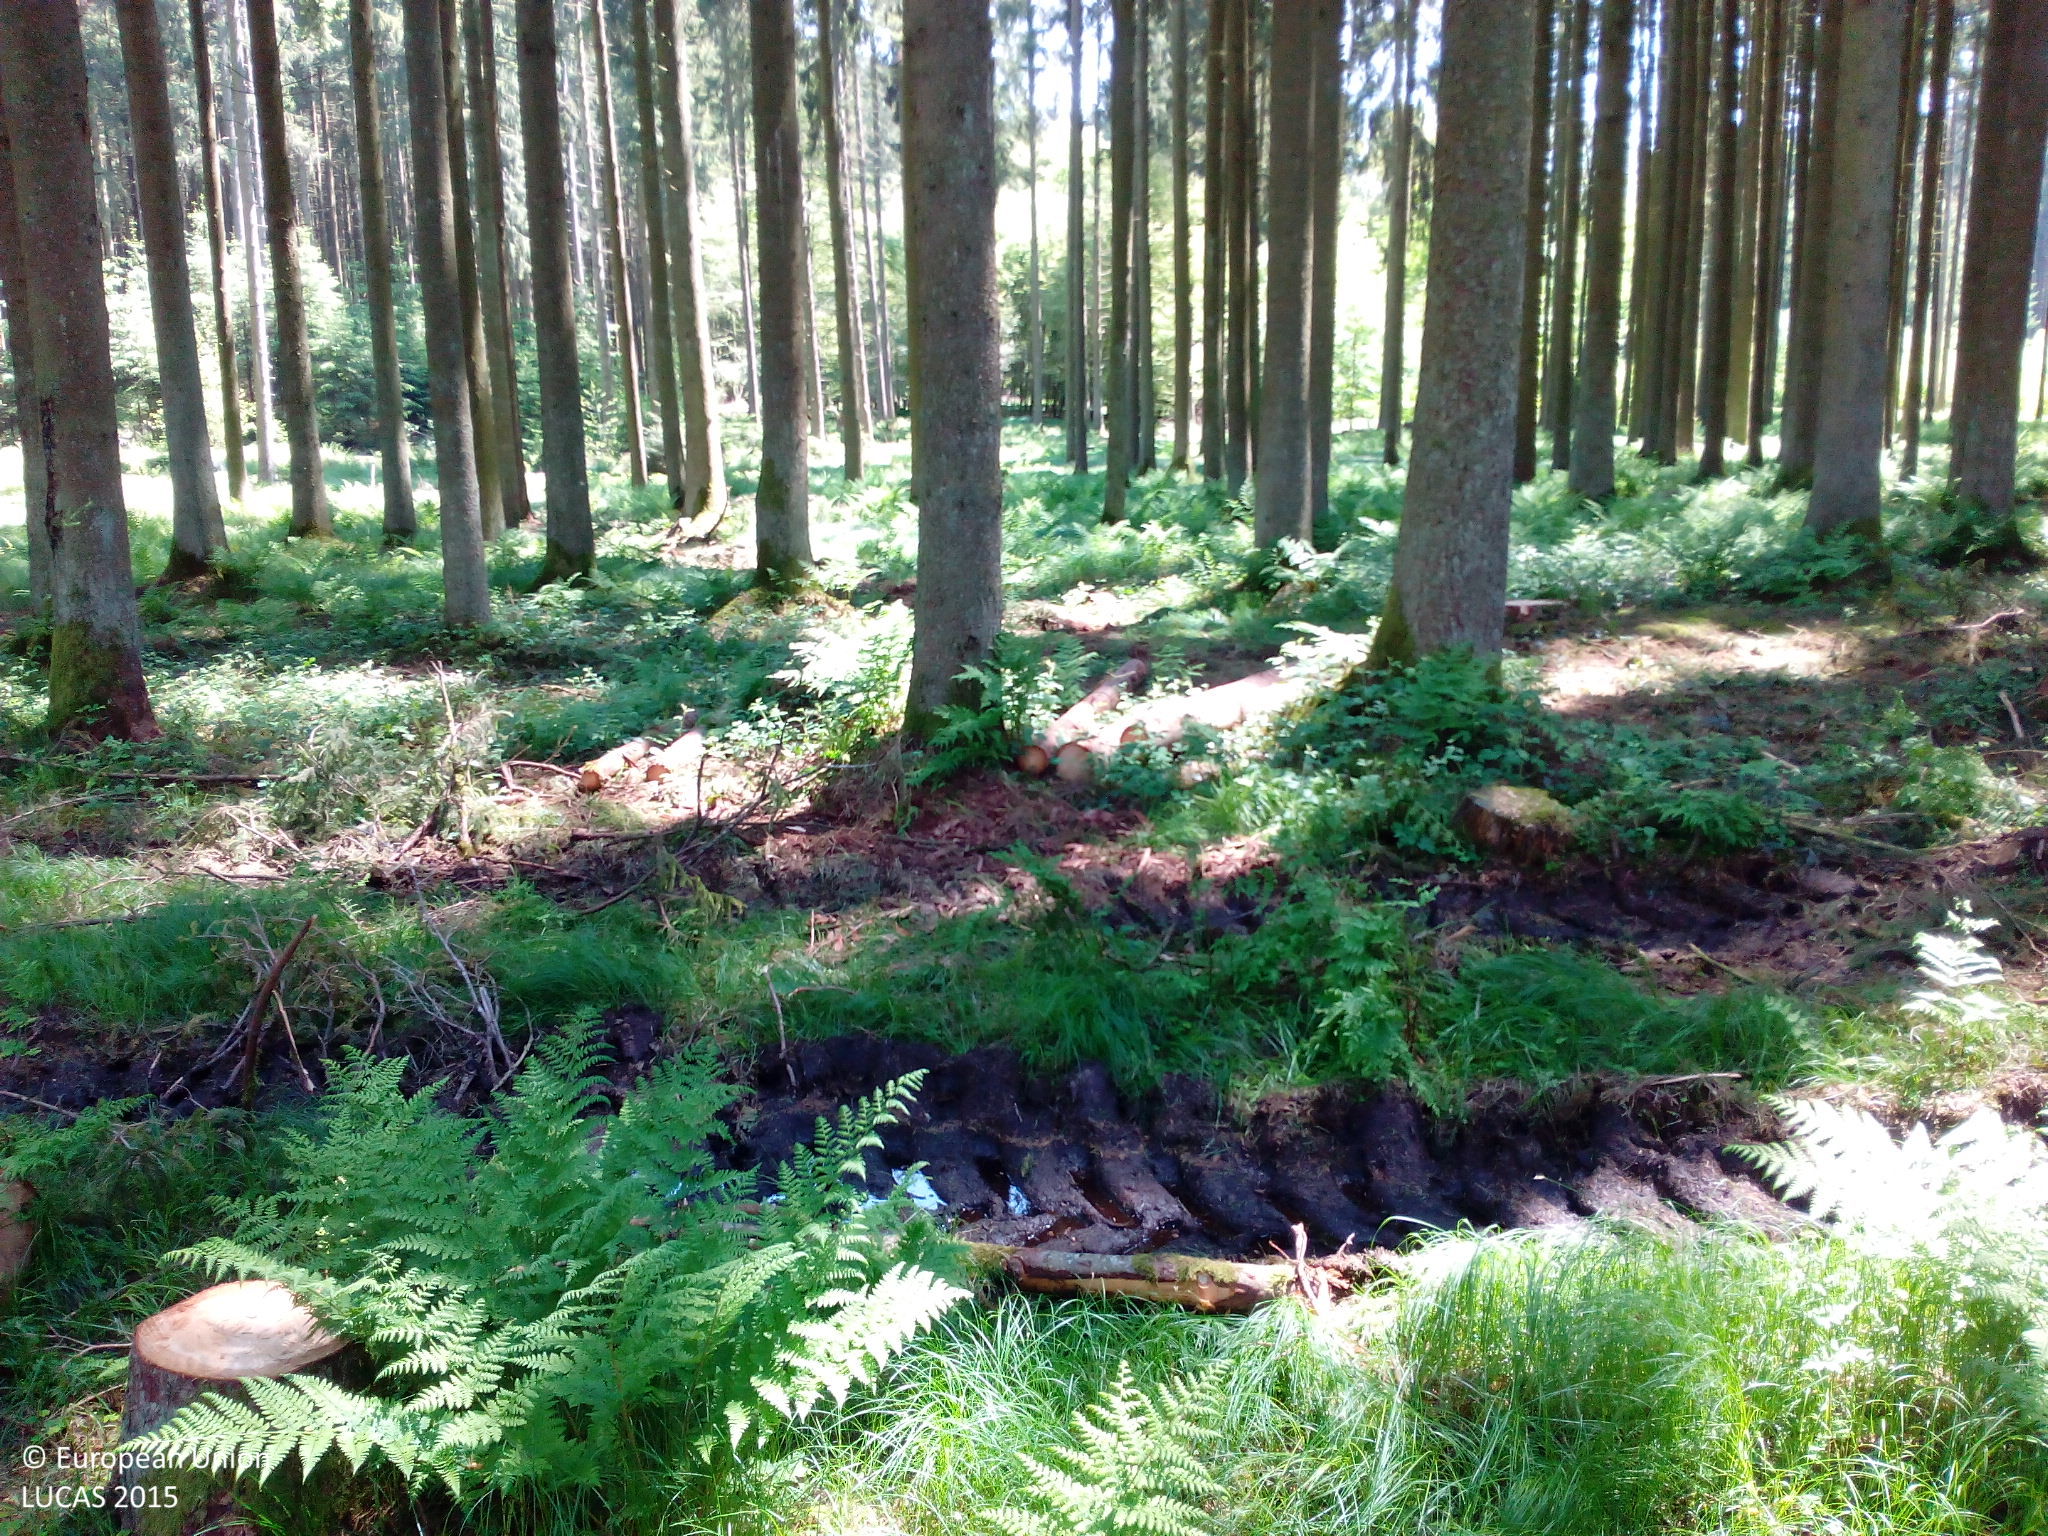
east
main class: Woodland
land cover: Spruce dominated coniferous woodland
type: hemiboreal forest and nemoral coniferous forest and mixed broadleaved-coniferous forest
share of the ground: > 75 %
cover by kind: coniferous forest trees 75 %, herbaceous plants 15 %, shrubs 10 %
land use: Forestry
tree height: > 5 m
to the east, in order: Spruce dominated coniferous woodland; Tracks; Spruce dominated coniferous woodland; Ditches and canals; Spruce dominated coniferous woodland; Tracks; Spruce dominated coniferous woodland
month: May
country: DE
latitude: 48.2055
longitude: 9.9328
